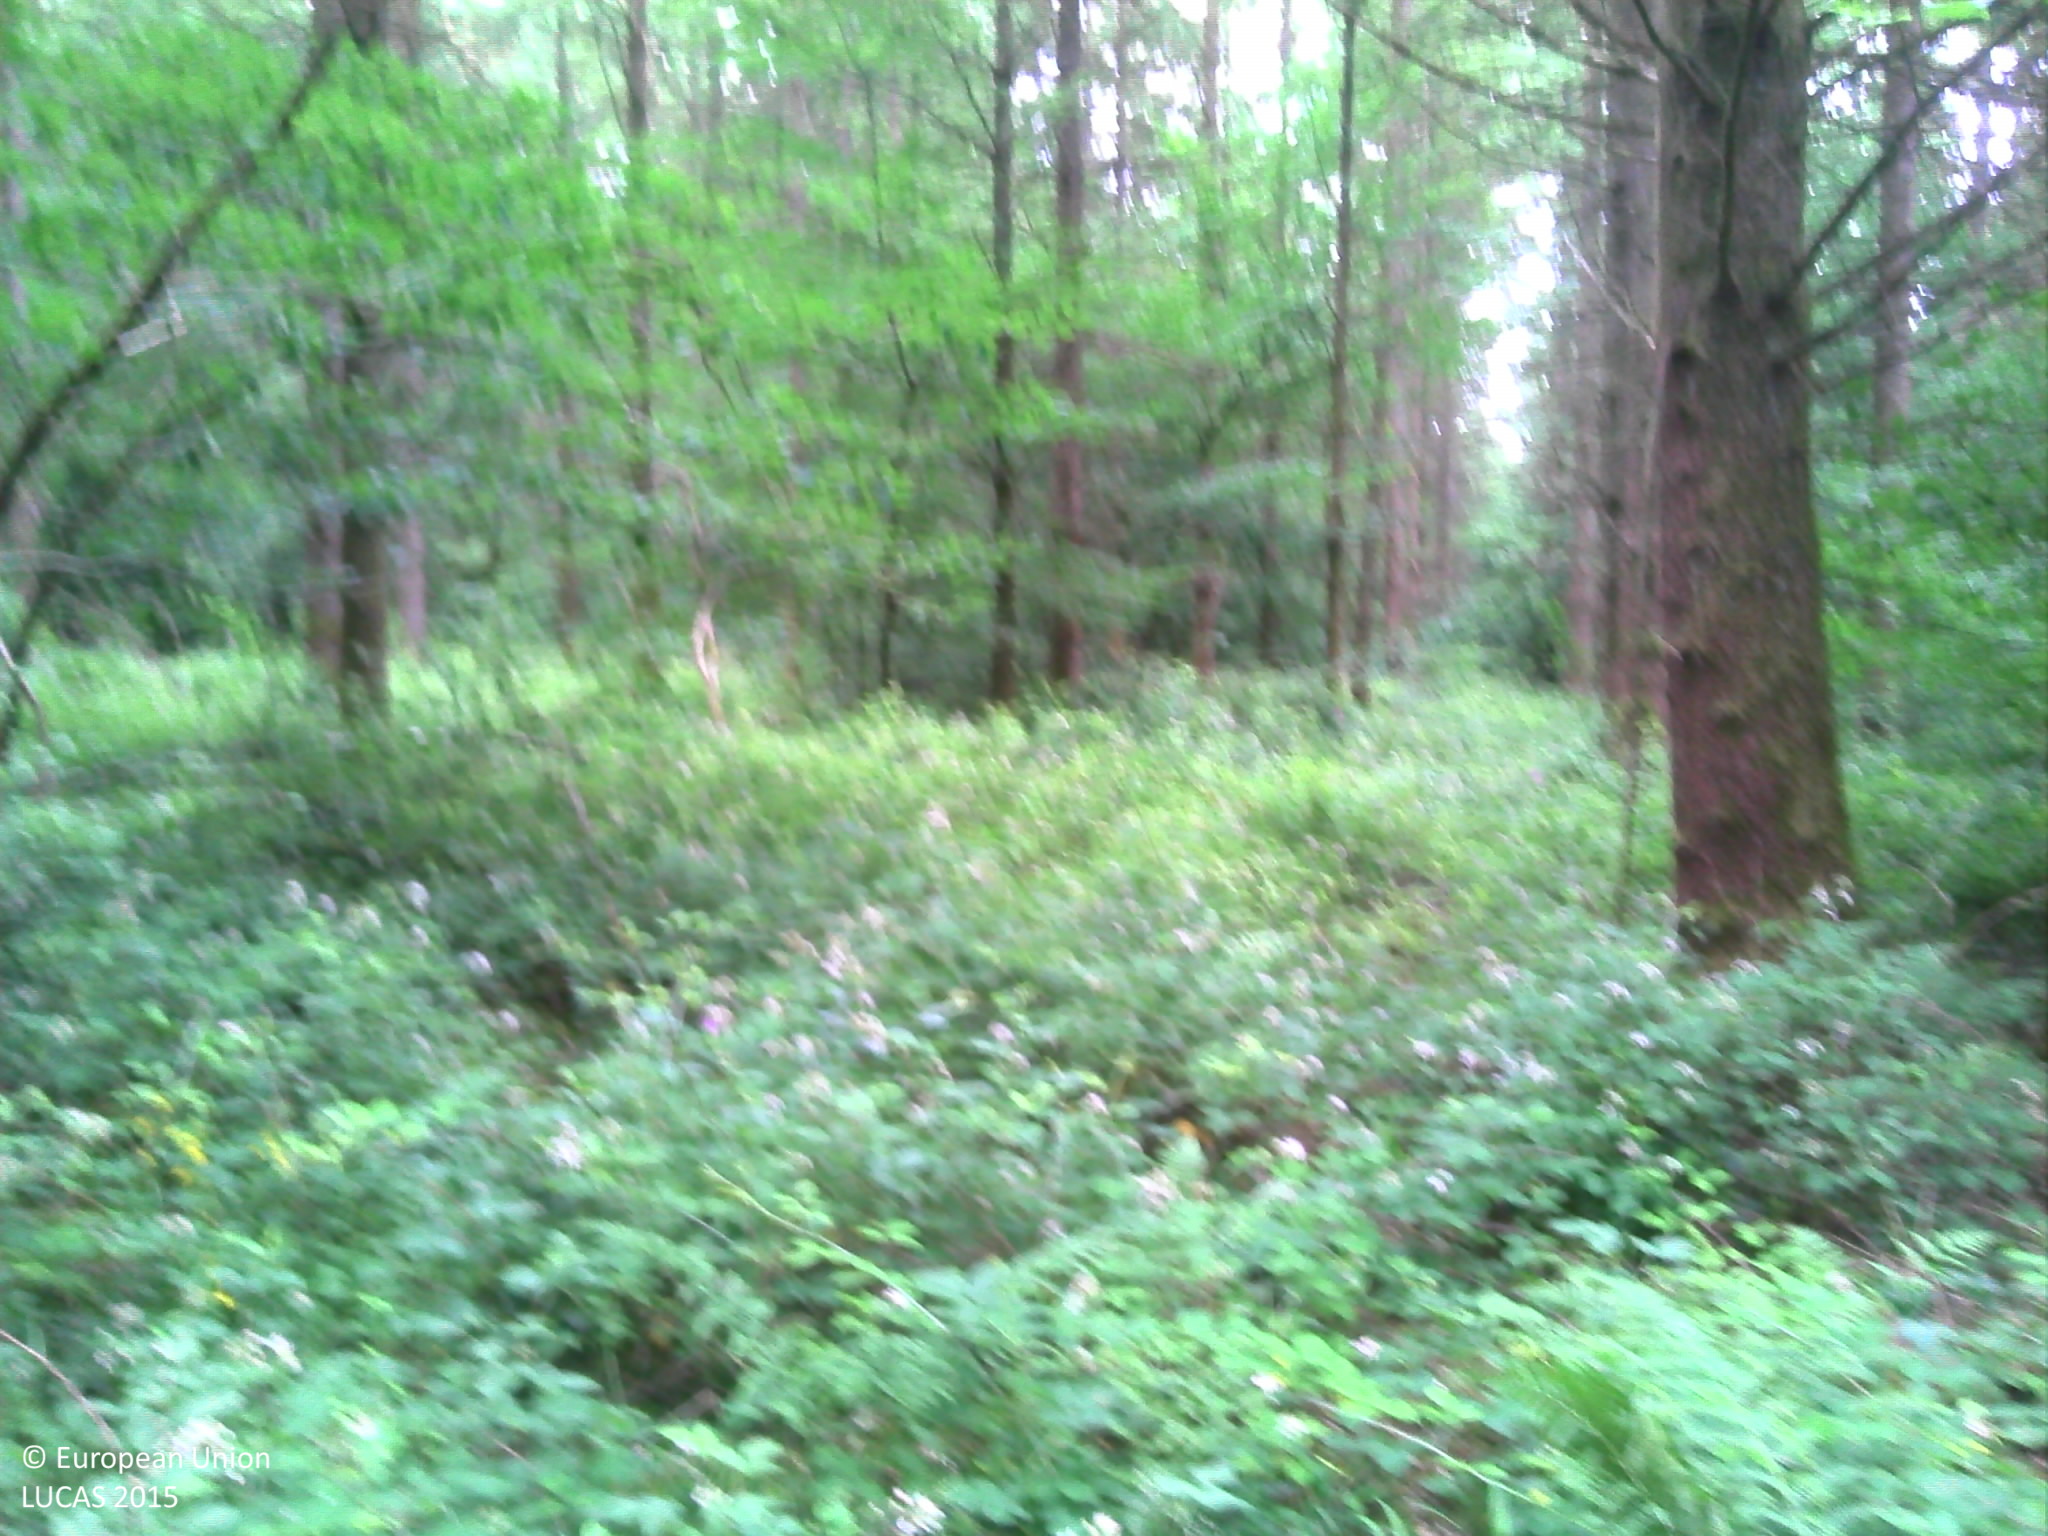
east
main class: Woodland
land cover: Spruce dominated coniferous woodland
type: exotic forest
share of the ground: > 75 %
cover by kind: coniferous forest trees 70 %, herbaceous plants 20 %, shrubs 10 %
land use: Forestry
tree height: > 5 m
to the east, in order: Spruce dominated coniferous woodland
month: June
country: FR
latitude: 46.5671
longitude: 4.4303
